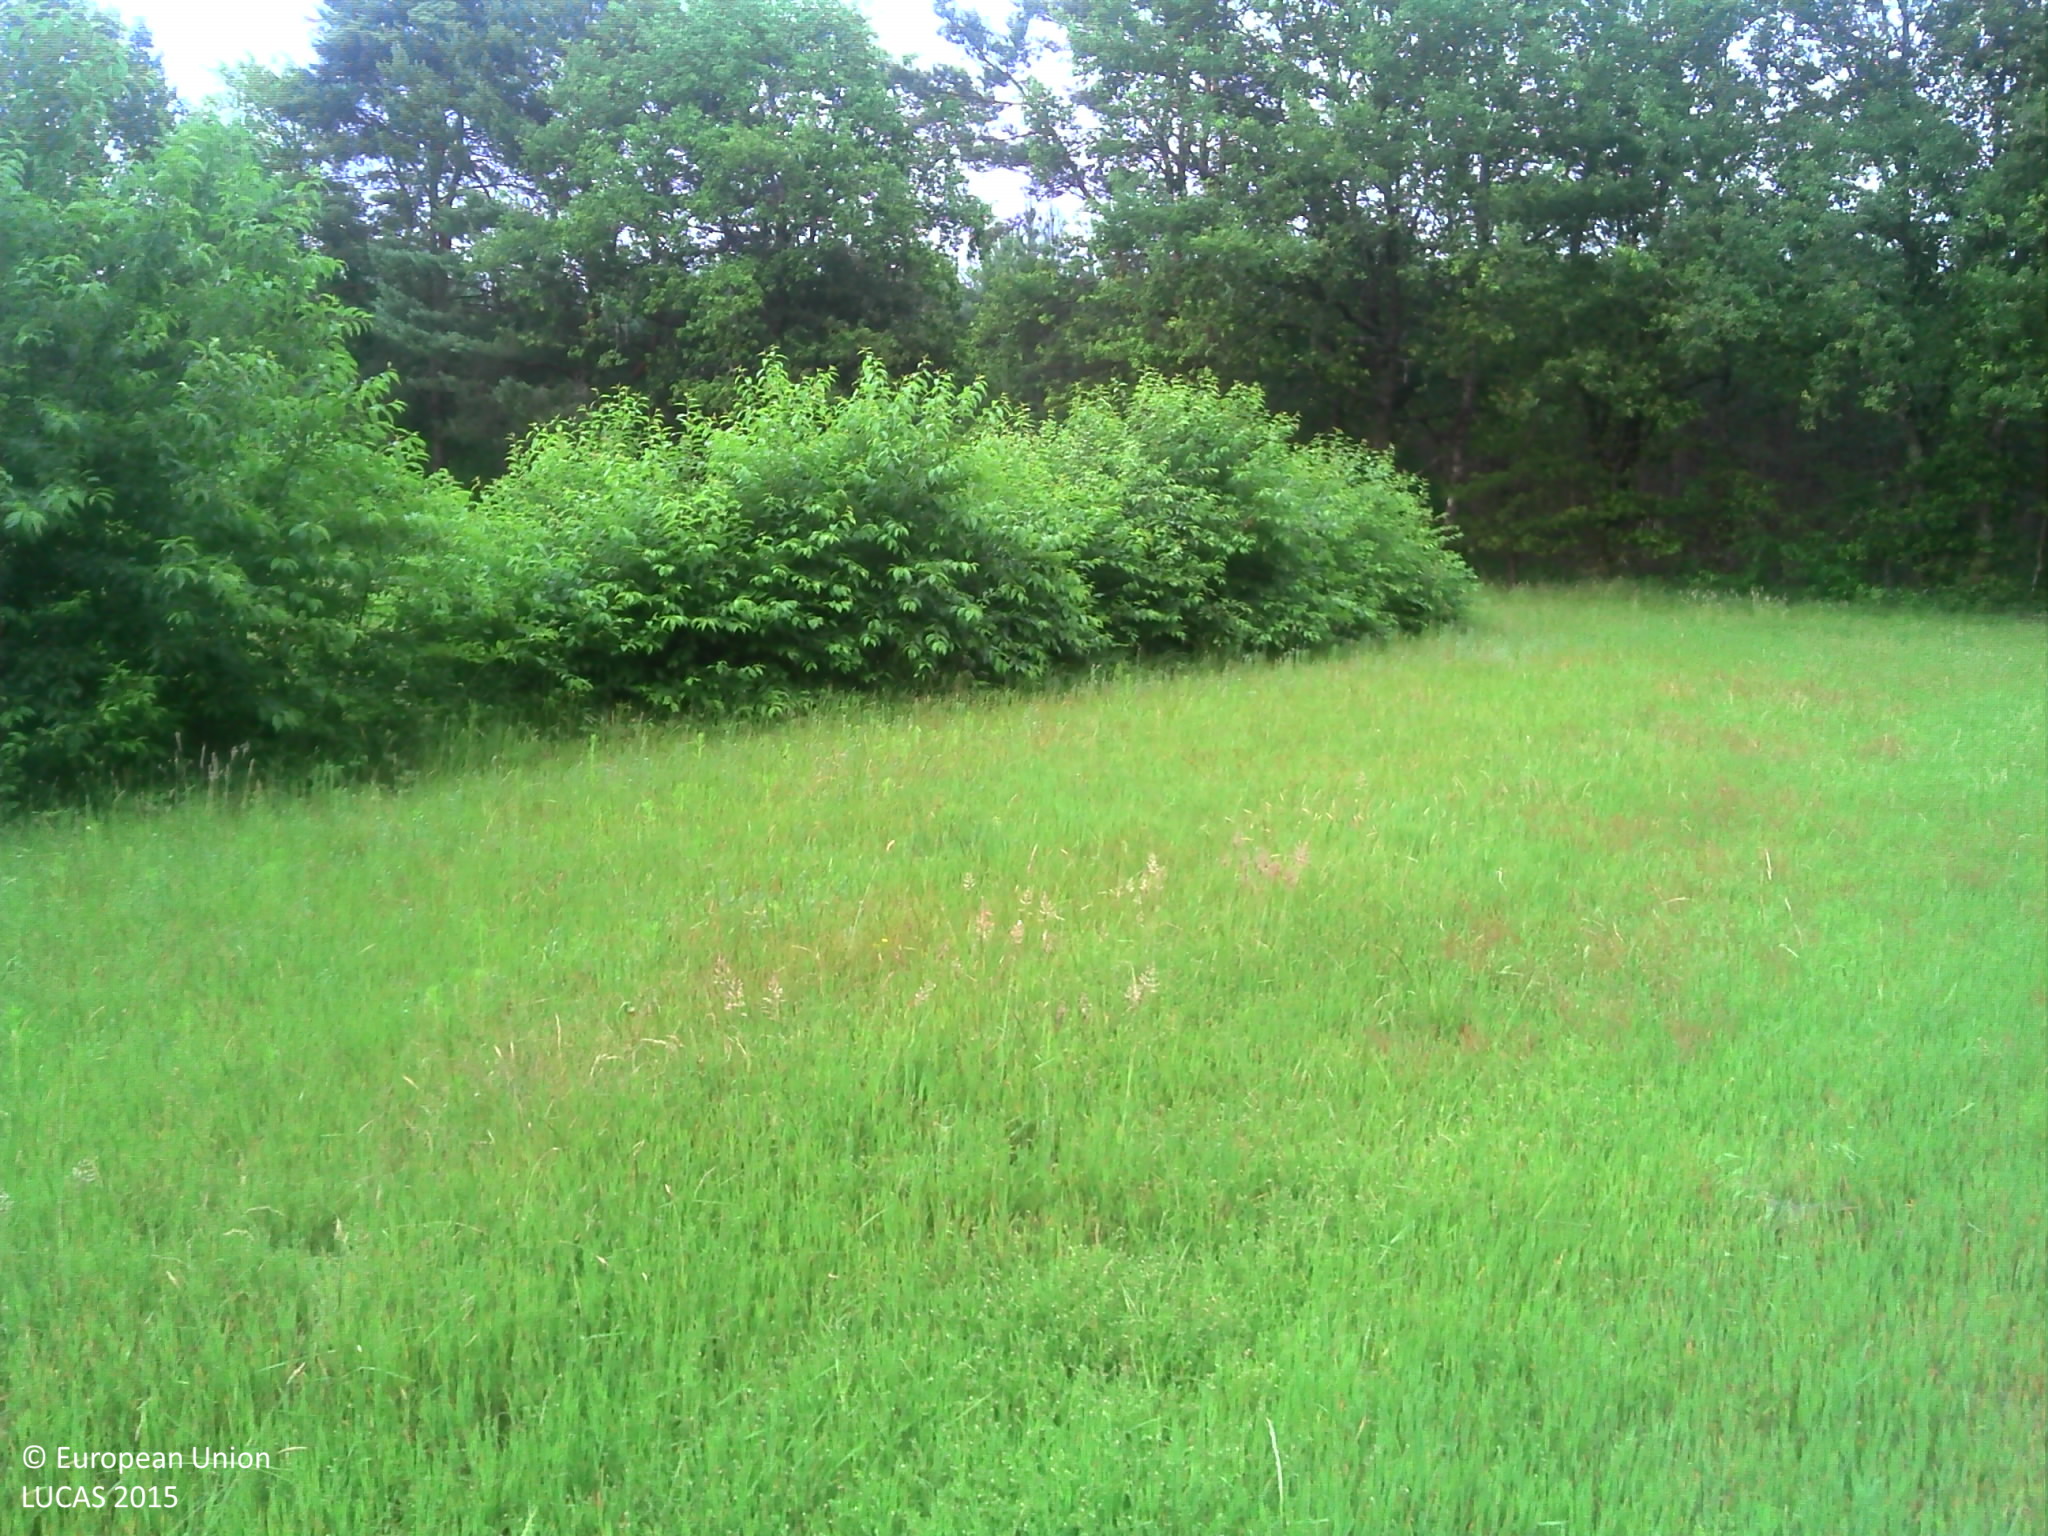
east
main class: Grassland
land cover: Grassland without tree/shrub cover
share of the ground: > 75 %
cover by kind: herbaceous plants 100 %
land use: Agriculture (excluding fallow land and kitchen gardens)
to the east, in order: Grassland without tree/shrub cover; Lines of trees; Tracks; Pine dominated coniferous woodland; Grassland without tree/shrub cover; Broadleaved woodland; Tracks; Broadleaved woodland; Tracks; Broadleaved woodland
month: June
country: FR
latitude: 47.4534
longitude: 2.1249
